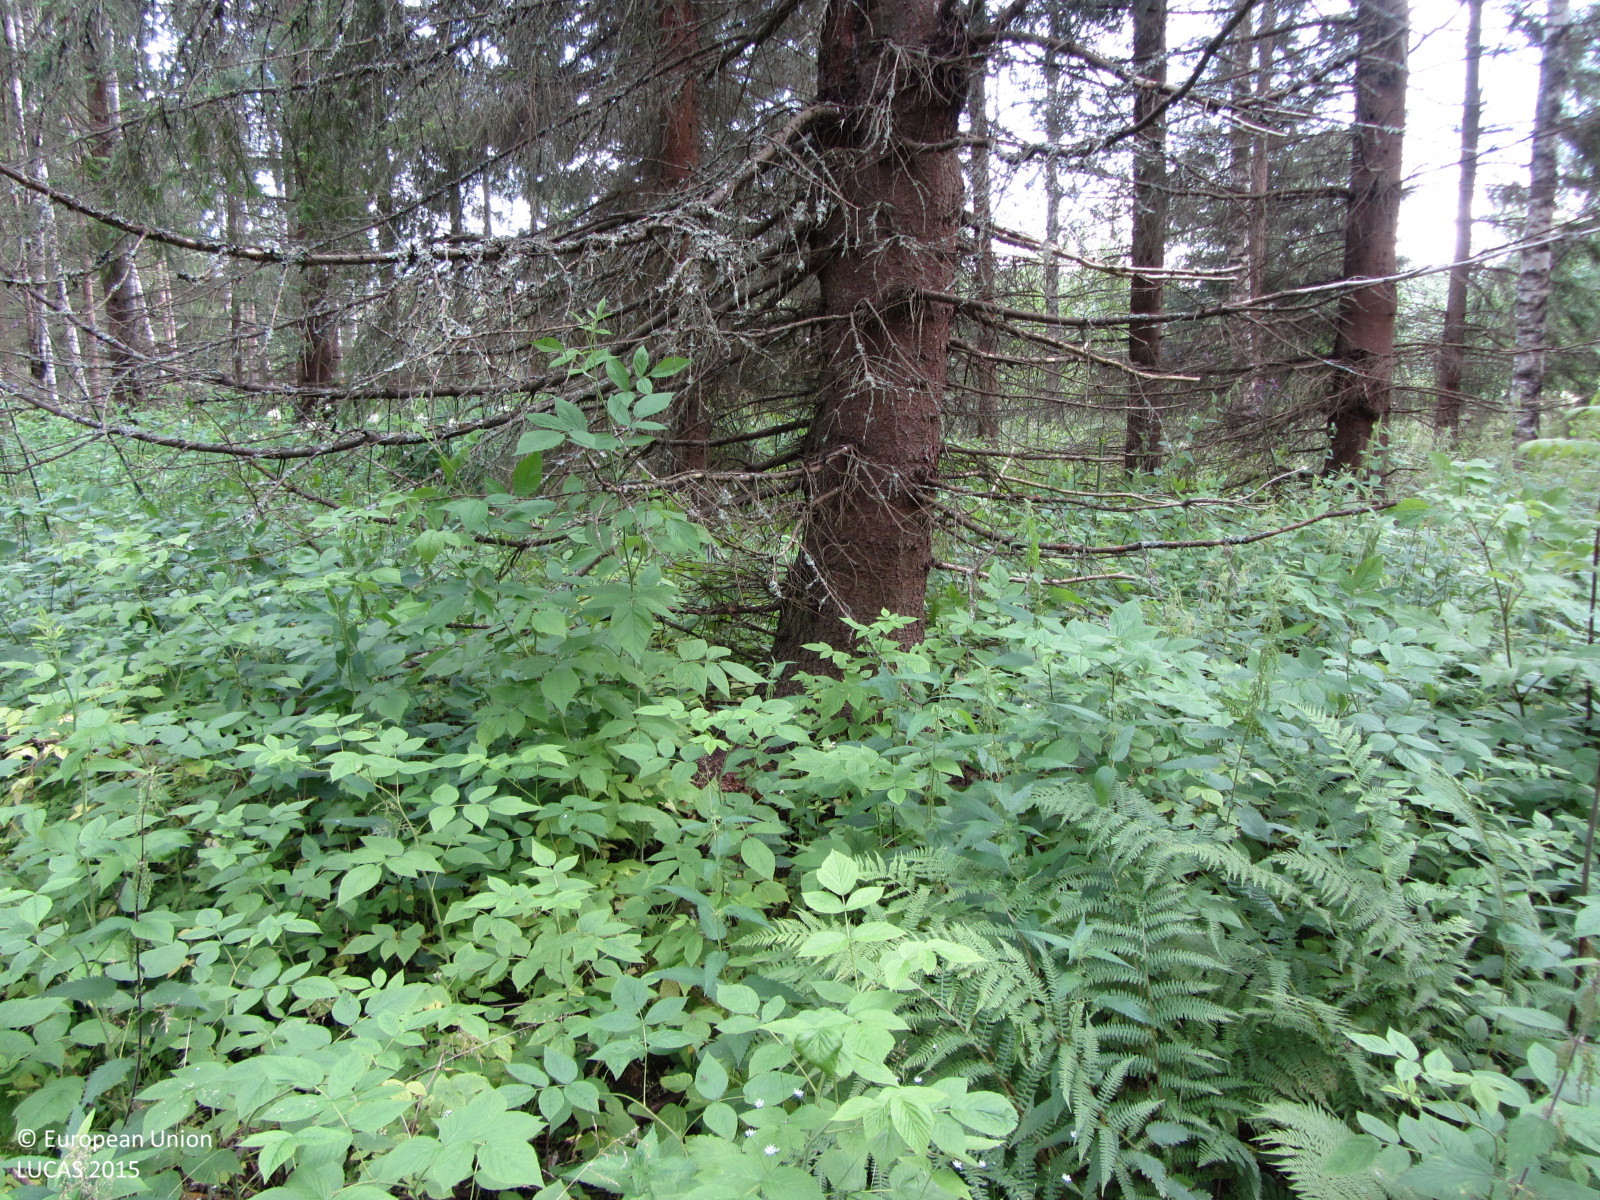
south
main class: Woodland
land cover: Spruce dominated mixed woodland
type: boreal forest
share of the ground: 25 - 50 %
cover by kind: herbaceous plants 55 %, coniferous forest trees 30 %, broadleaved forest trees 15 %
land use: Forestry
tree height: > 5 m
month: July
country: FI
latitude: 60.7033
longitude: 24.7481
